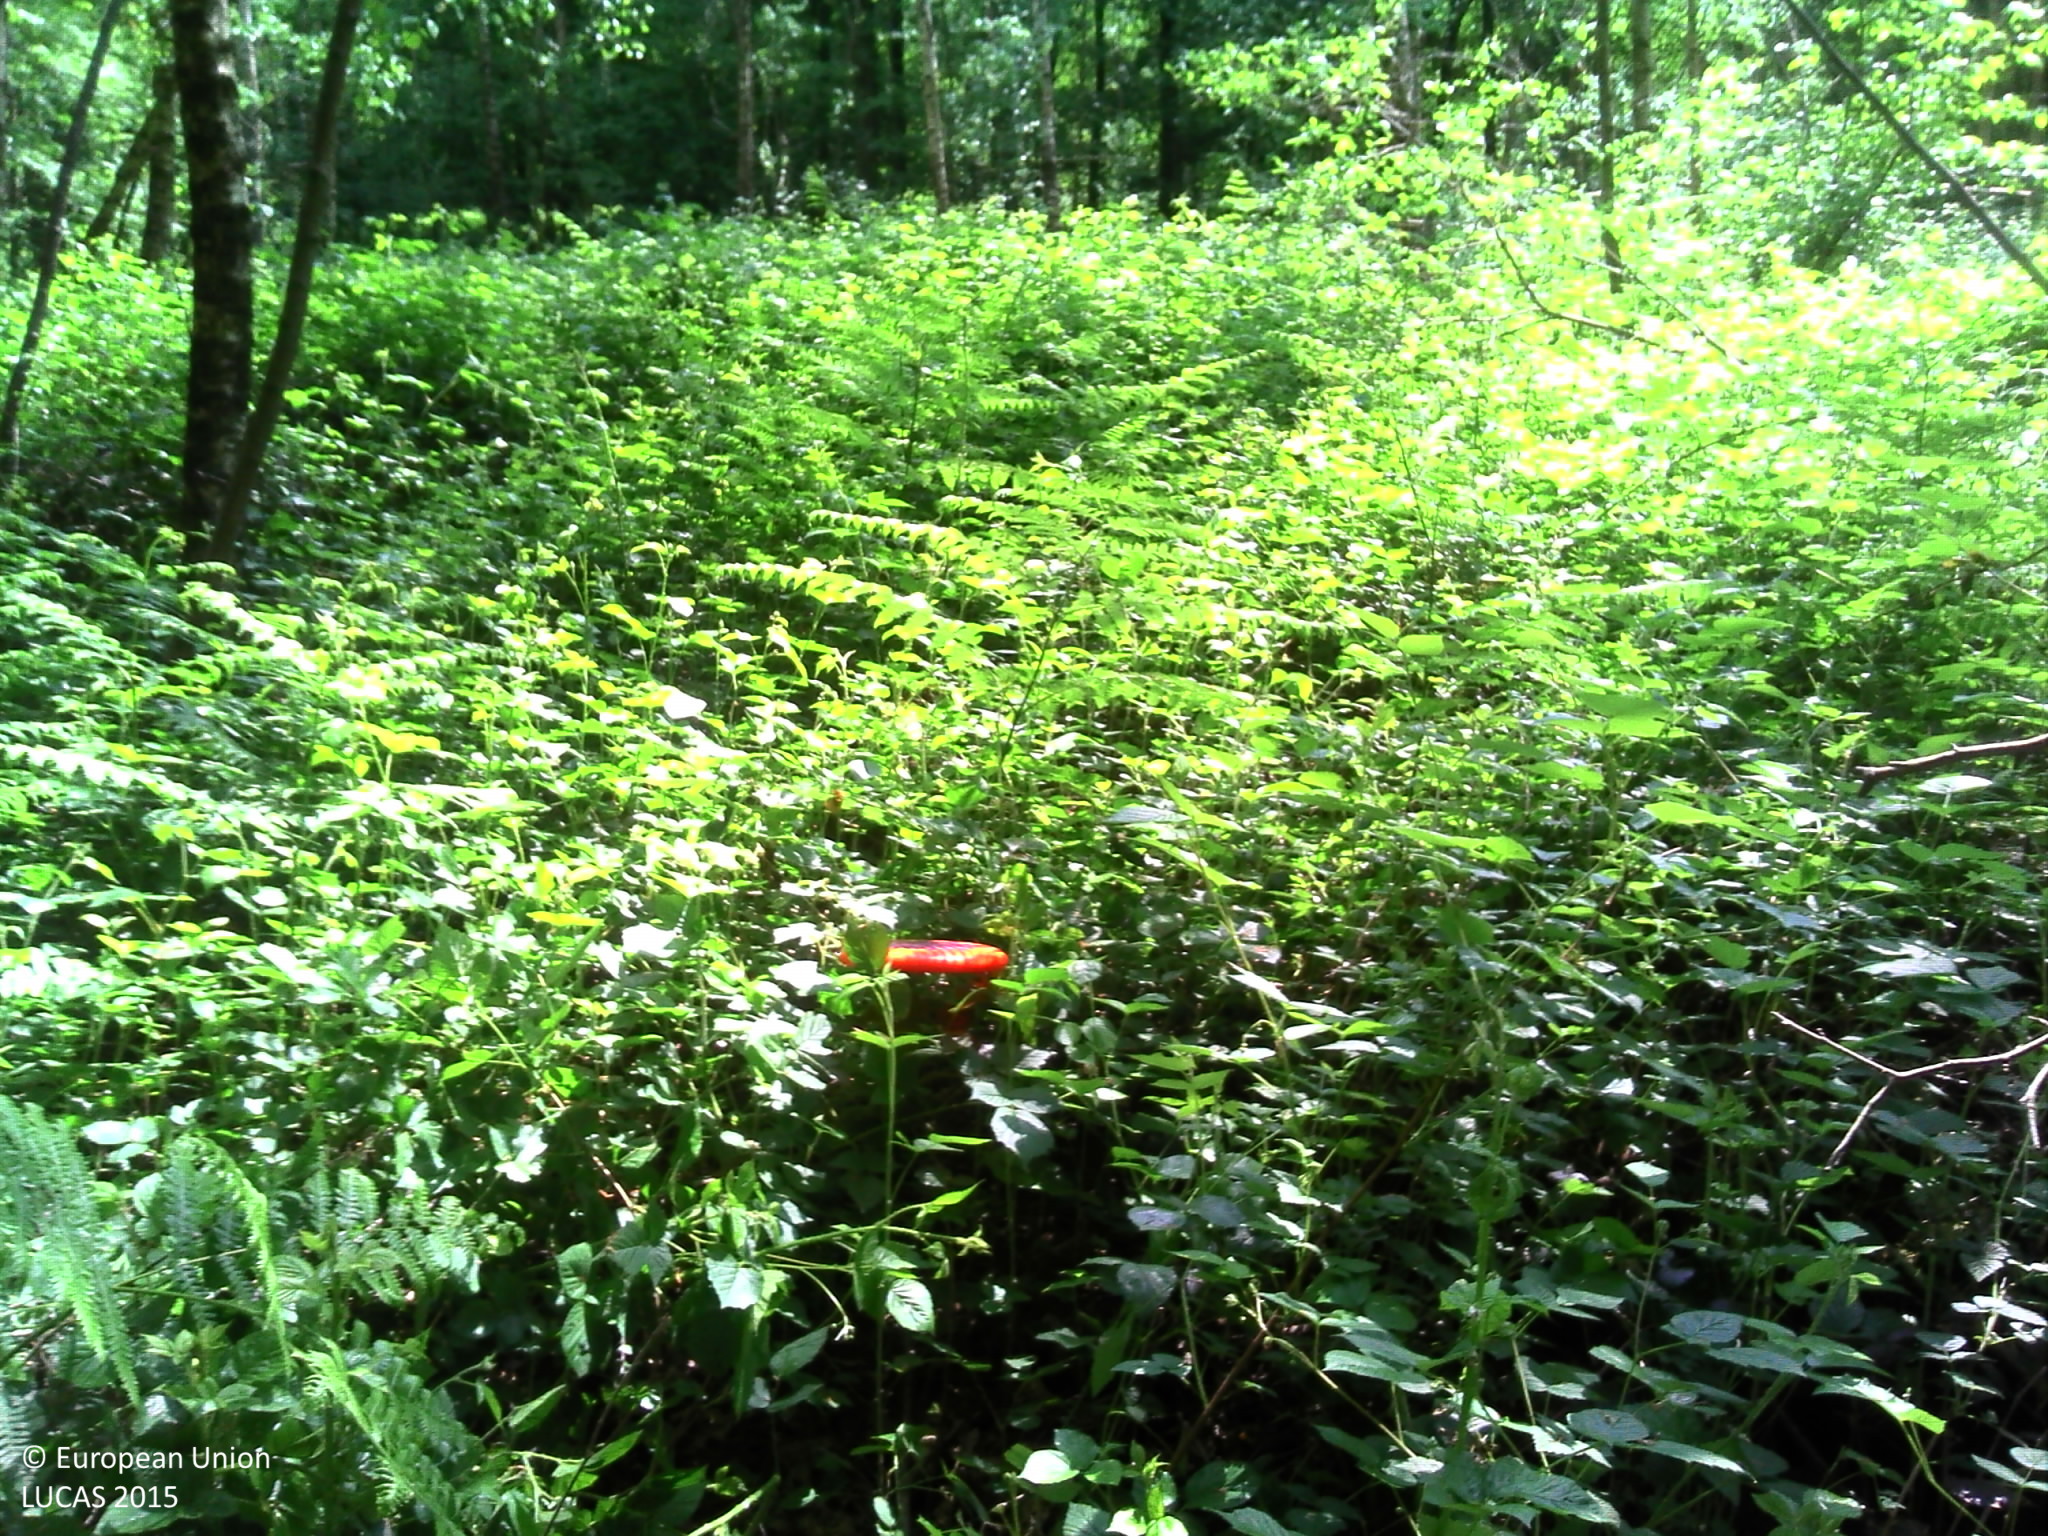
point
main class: Woodland
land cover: Broadleaved woodland
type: acidophilous oak and oak-birch forest
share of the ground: > 75 %
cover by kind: broadleaved forest trees 100 %
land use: Forestry
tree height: > 5 m
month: May
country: BE
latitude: 50.6102
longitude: 4.4987
